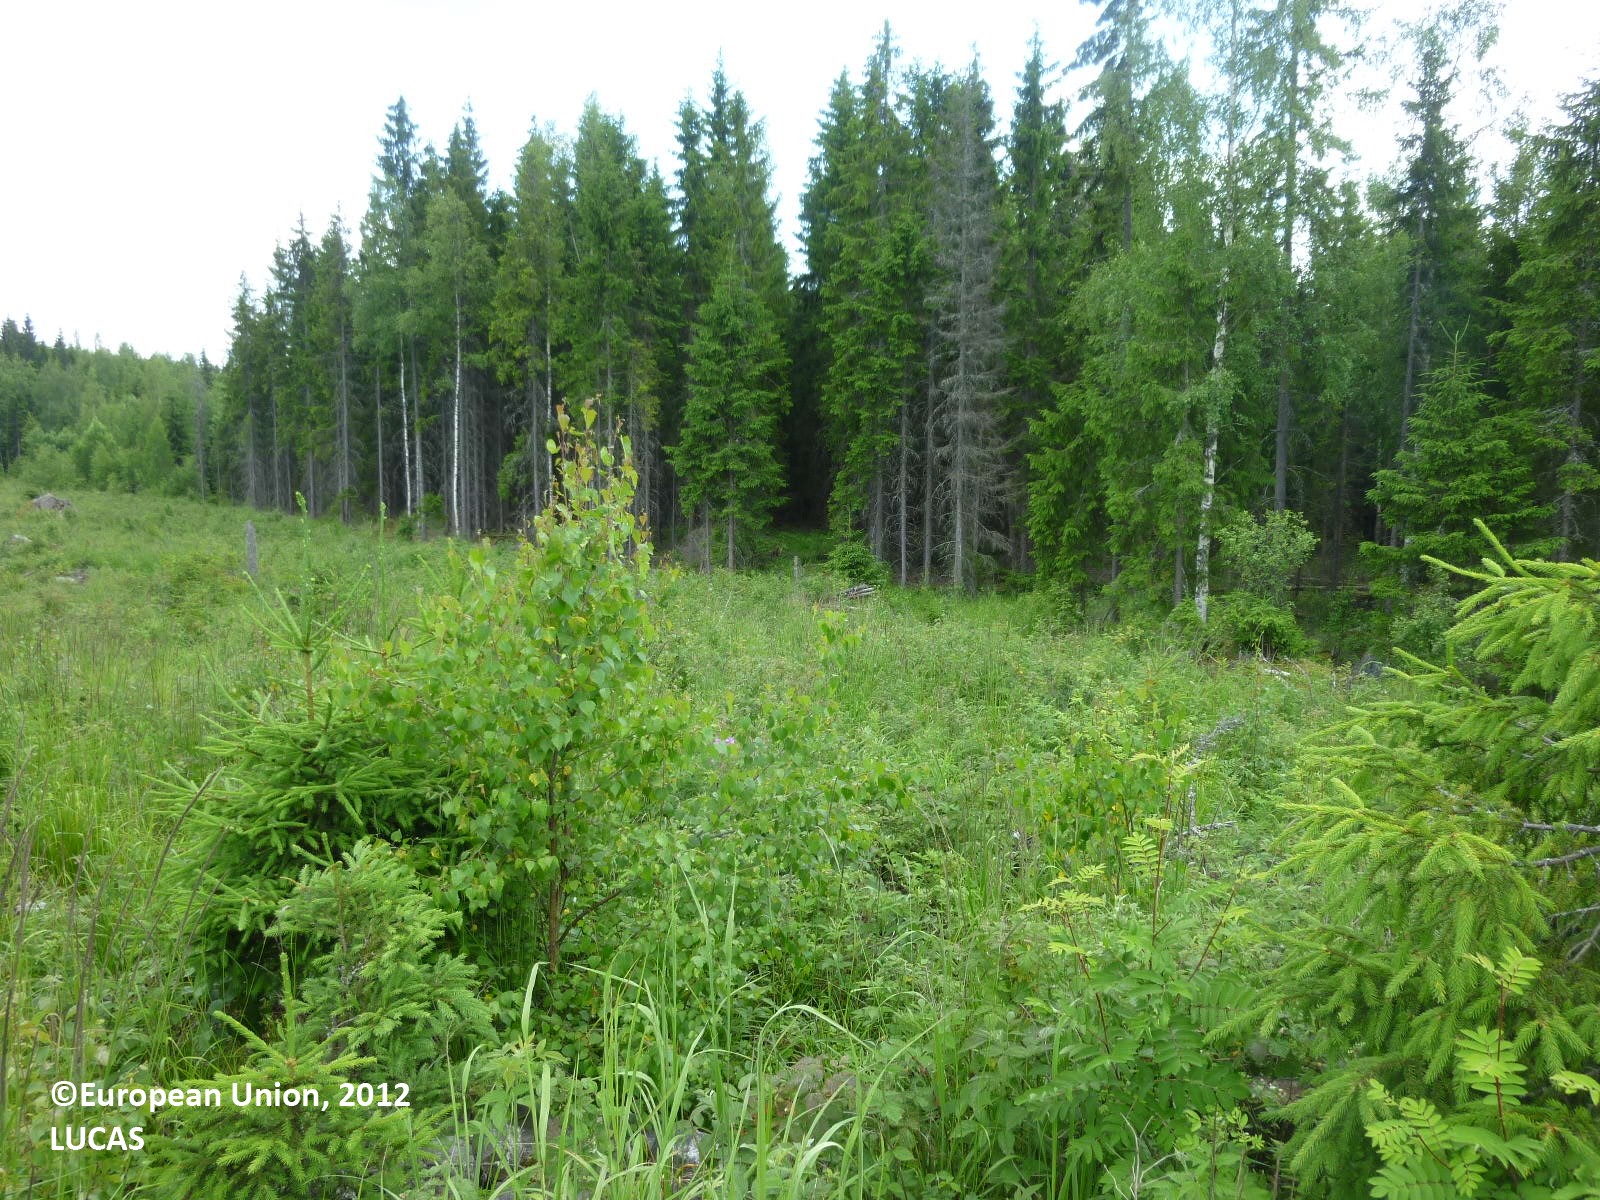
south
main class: Woodland
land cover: Spruce dominated mixed woodland
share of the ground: 50 - 75 %
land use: Forestry
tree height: < 5 m
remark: Clear cut
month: July
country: FI
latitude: 61.3794
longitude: 22.2437
